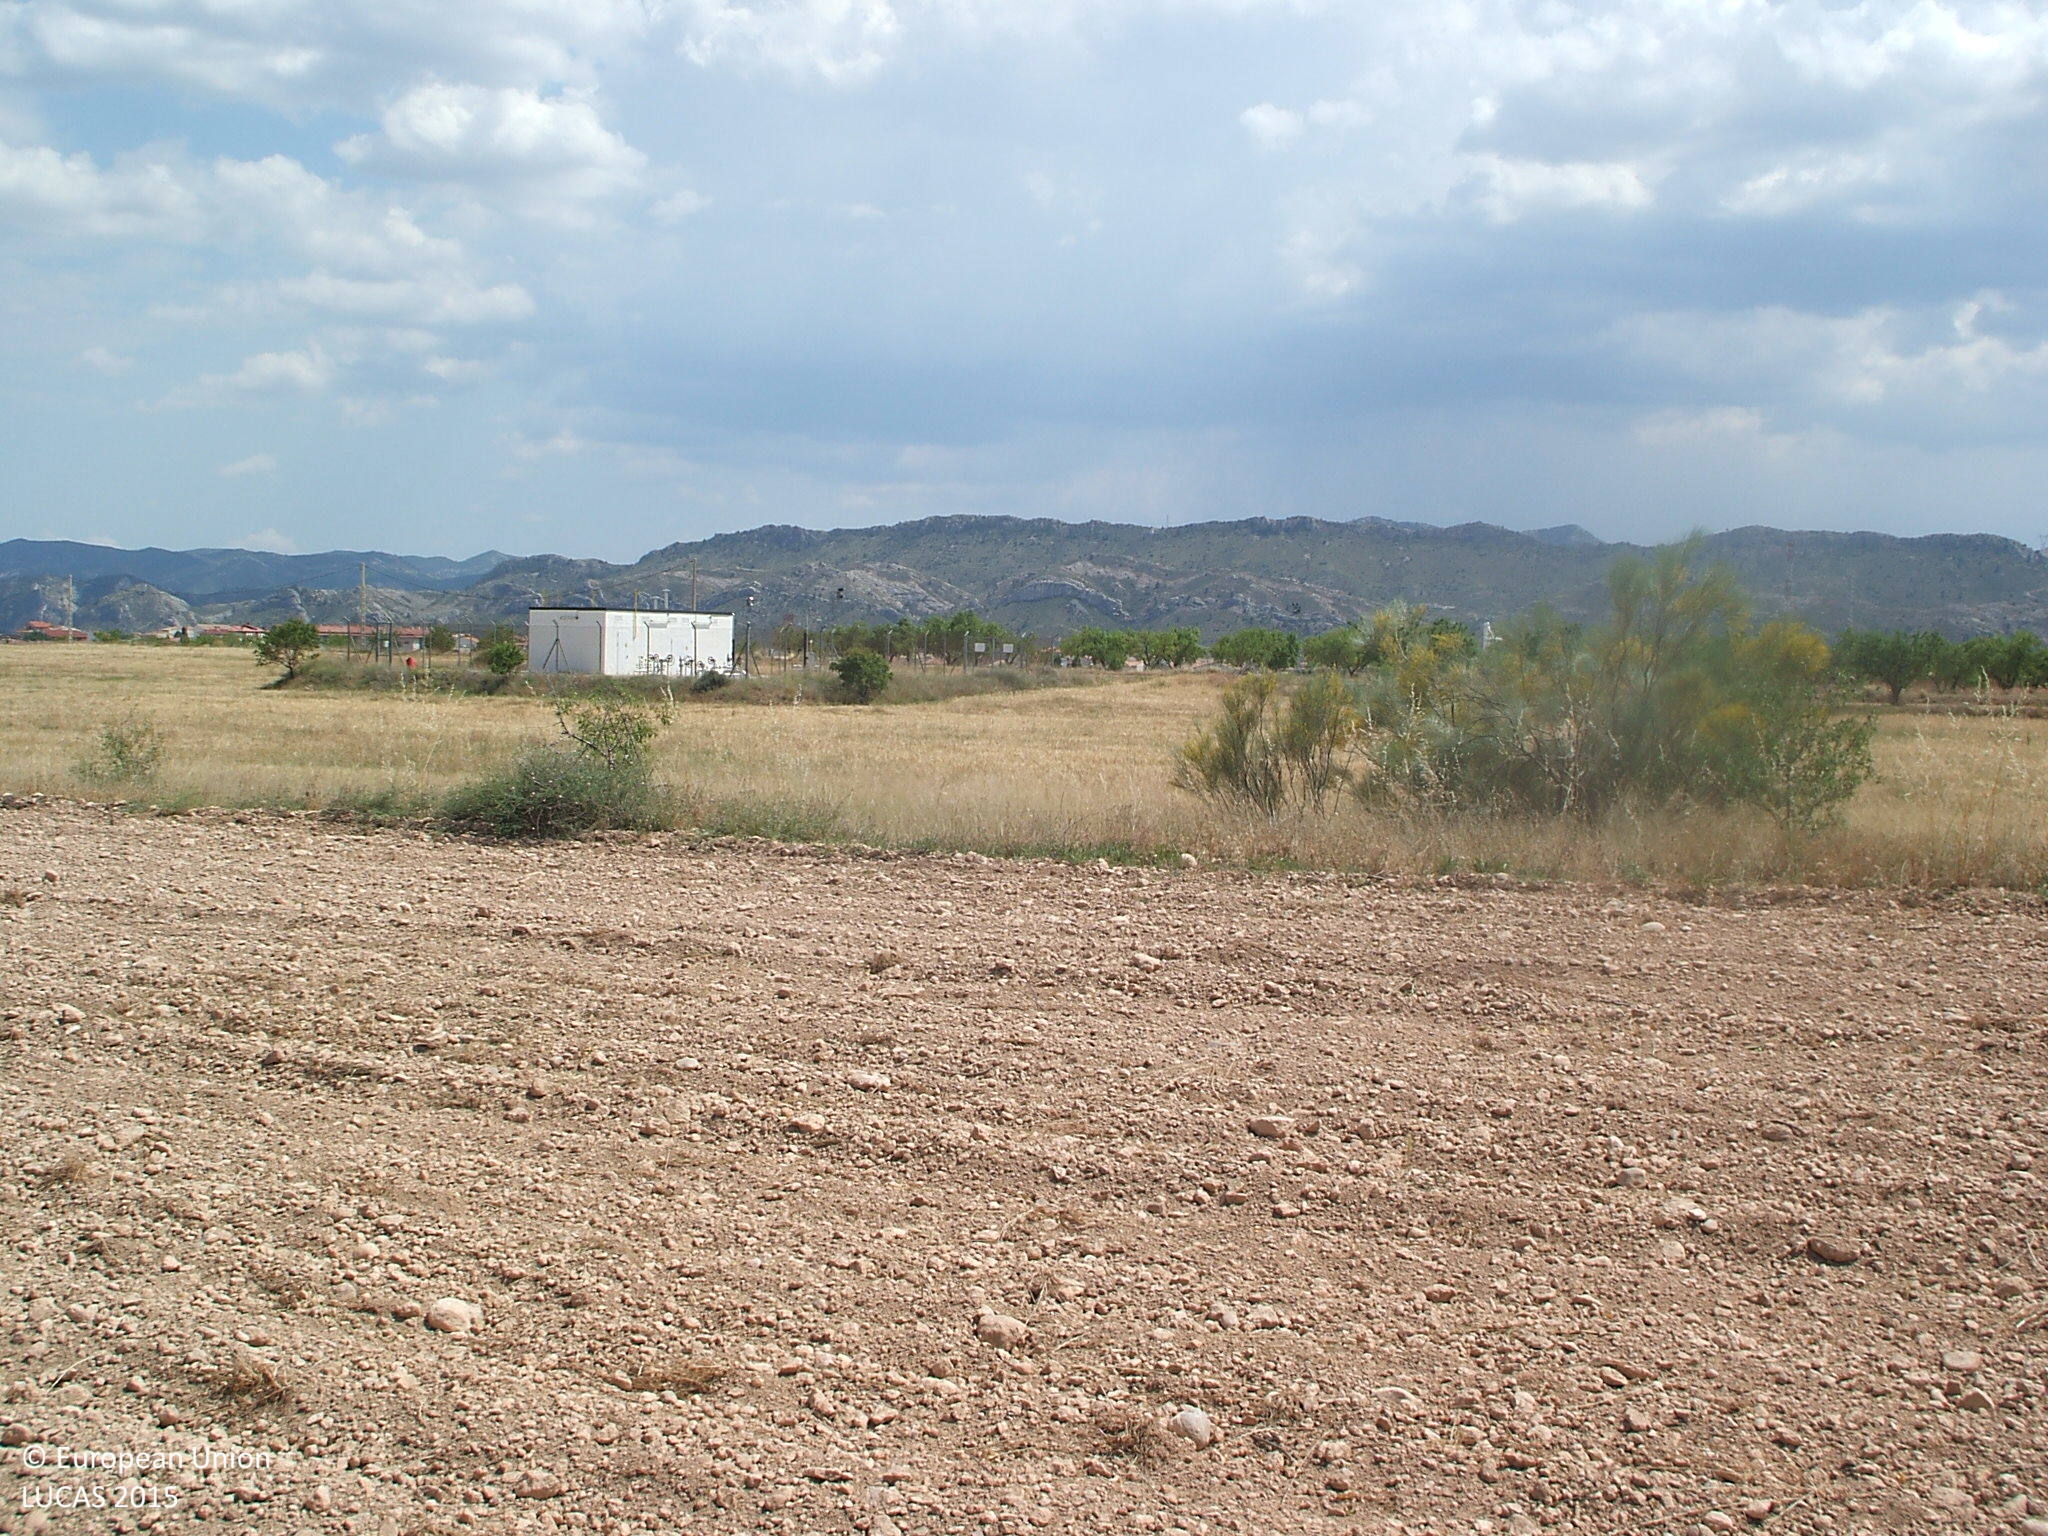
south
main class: Cropland
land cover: Nuts trees
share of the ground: 25 - 50 %
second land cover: Other bare soil
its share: > 75 %
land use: Agriculture (excluding fallow land and kitchen gardens)
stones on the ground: > 50 %
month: June
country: ES
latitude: 40.9508
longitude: -0.2395
